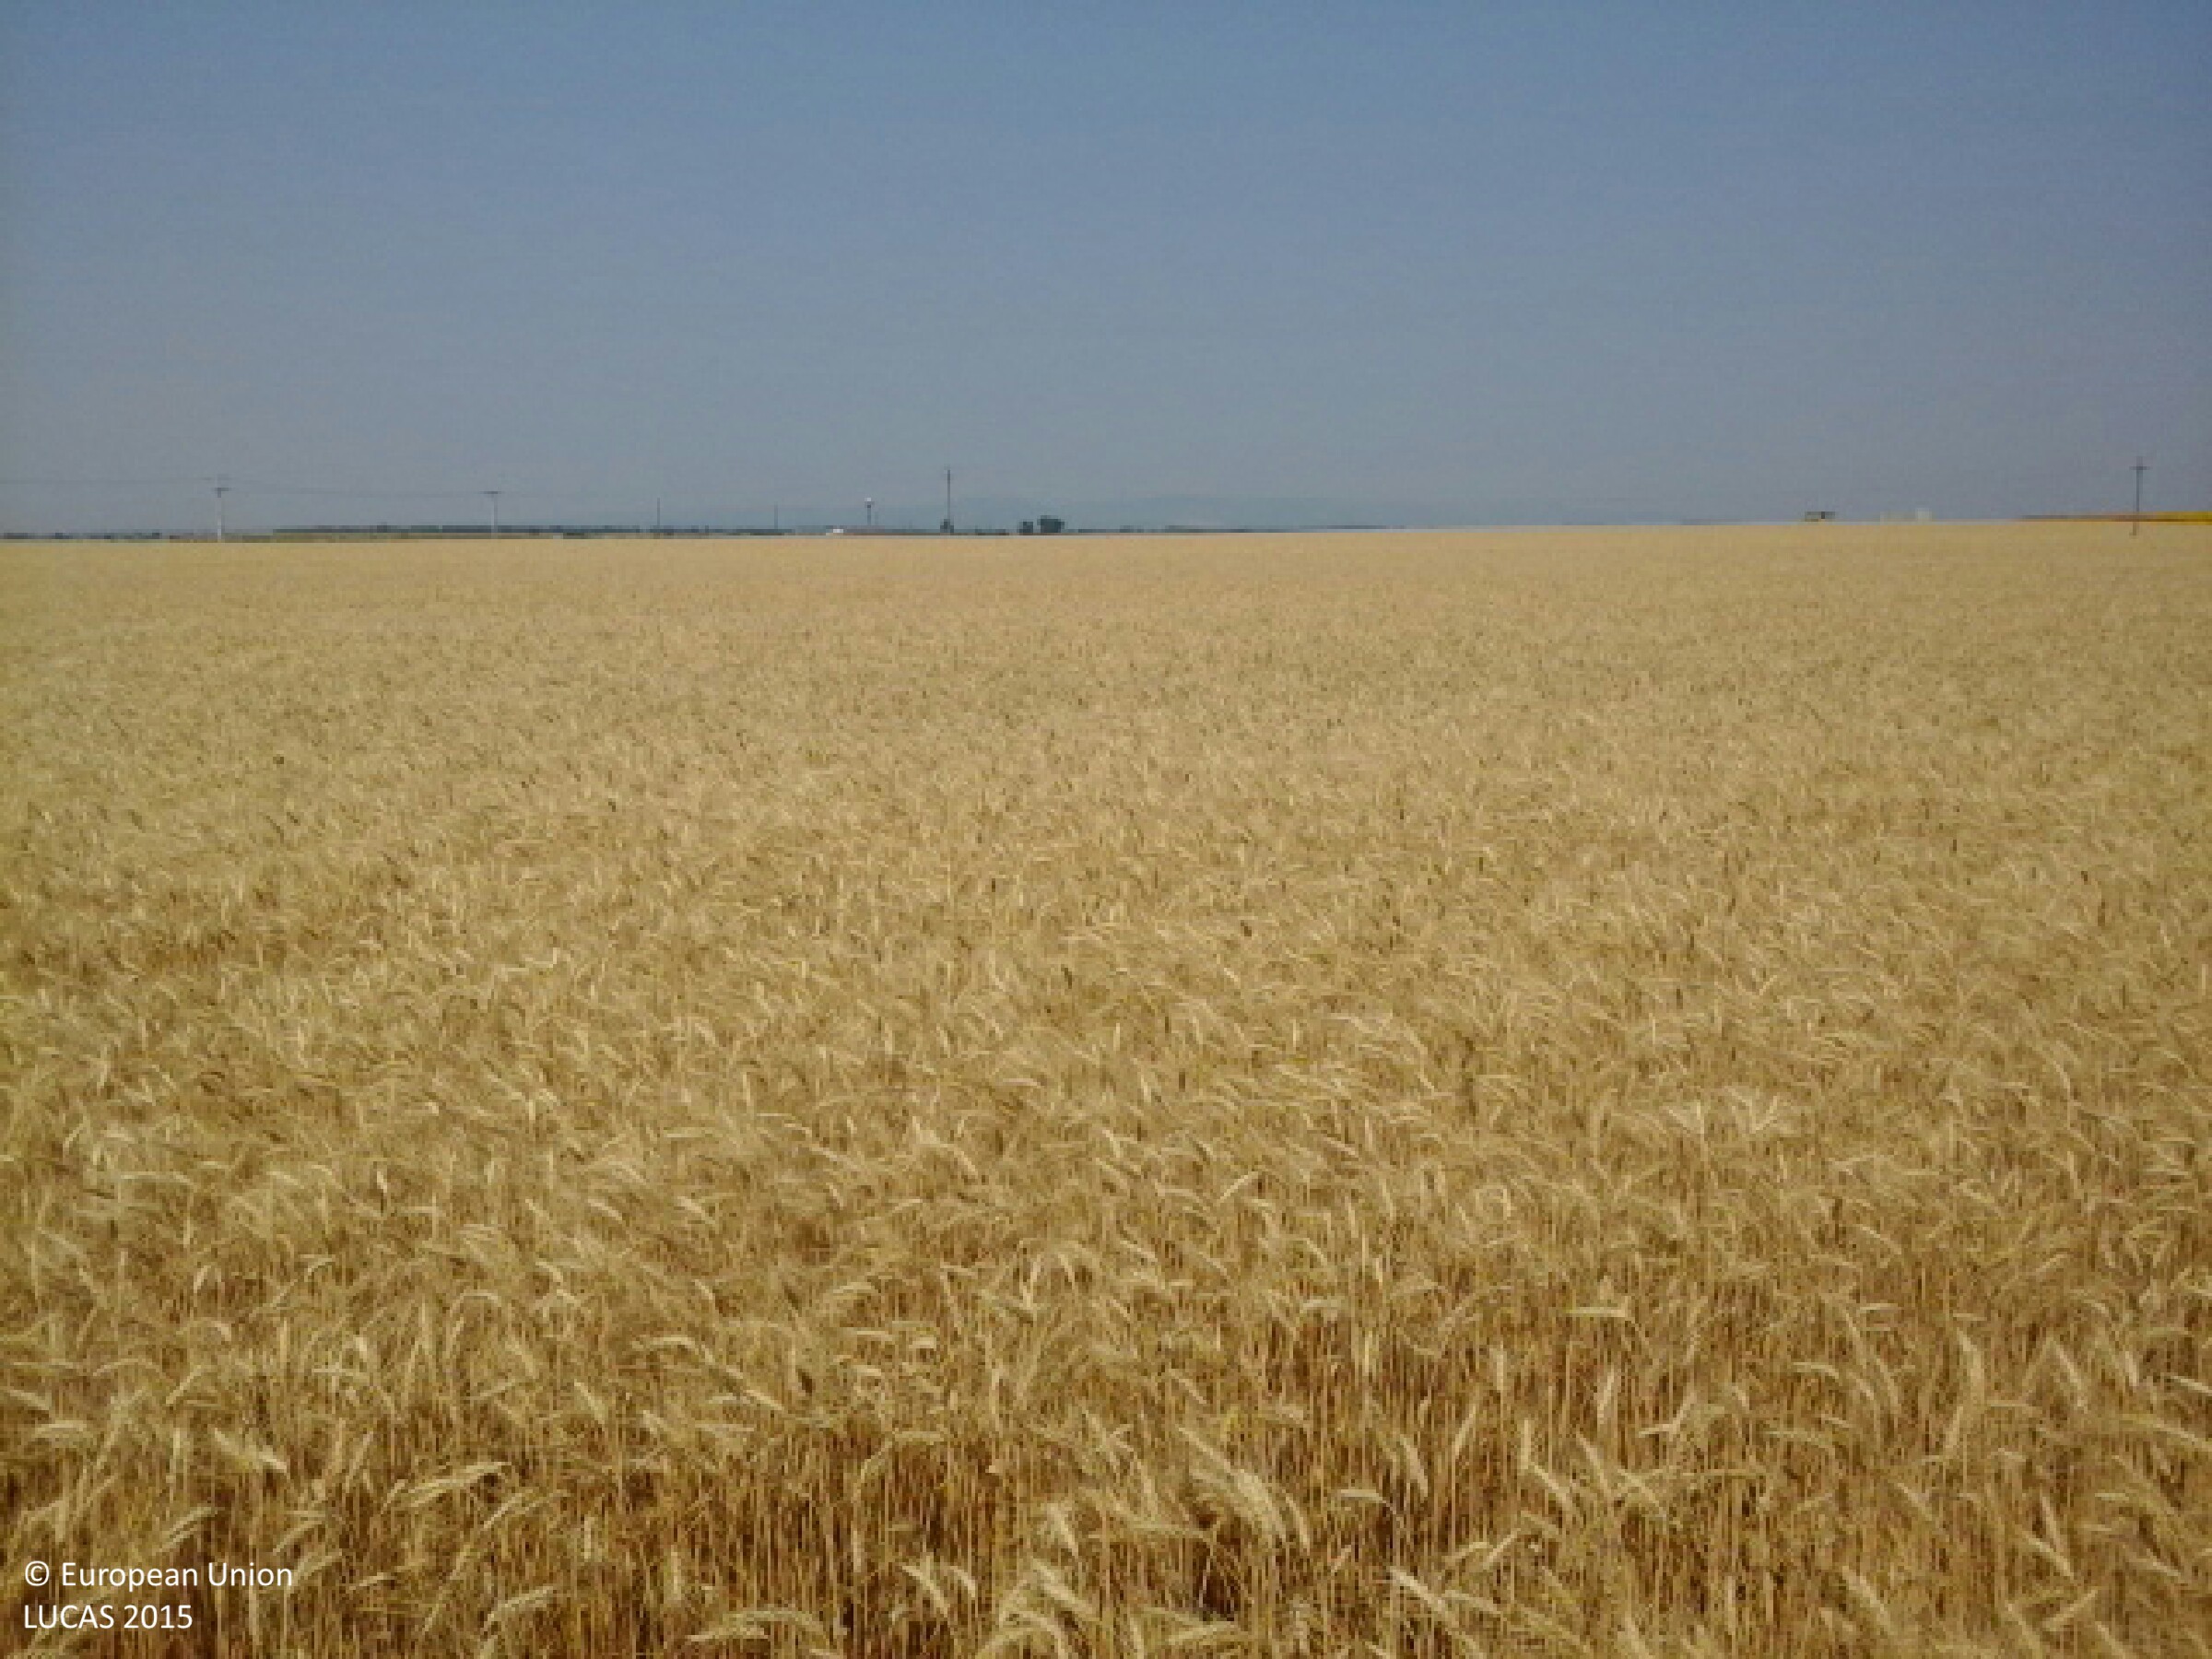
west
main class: Cropland
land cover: Triticale
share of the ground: > 75 %
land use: Agriculture (excluding fallow land and kitchen gardens)
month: July
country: HU
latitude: 48.0295
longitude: 21.0493
